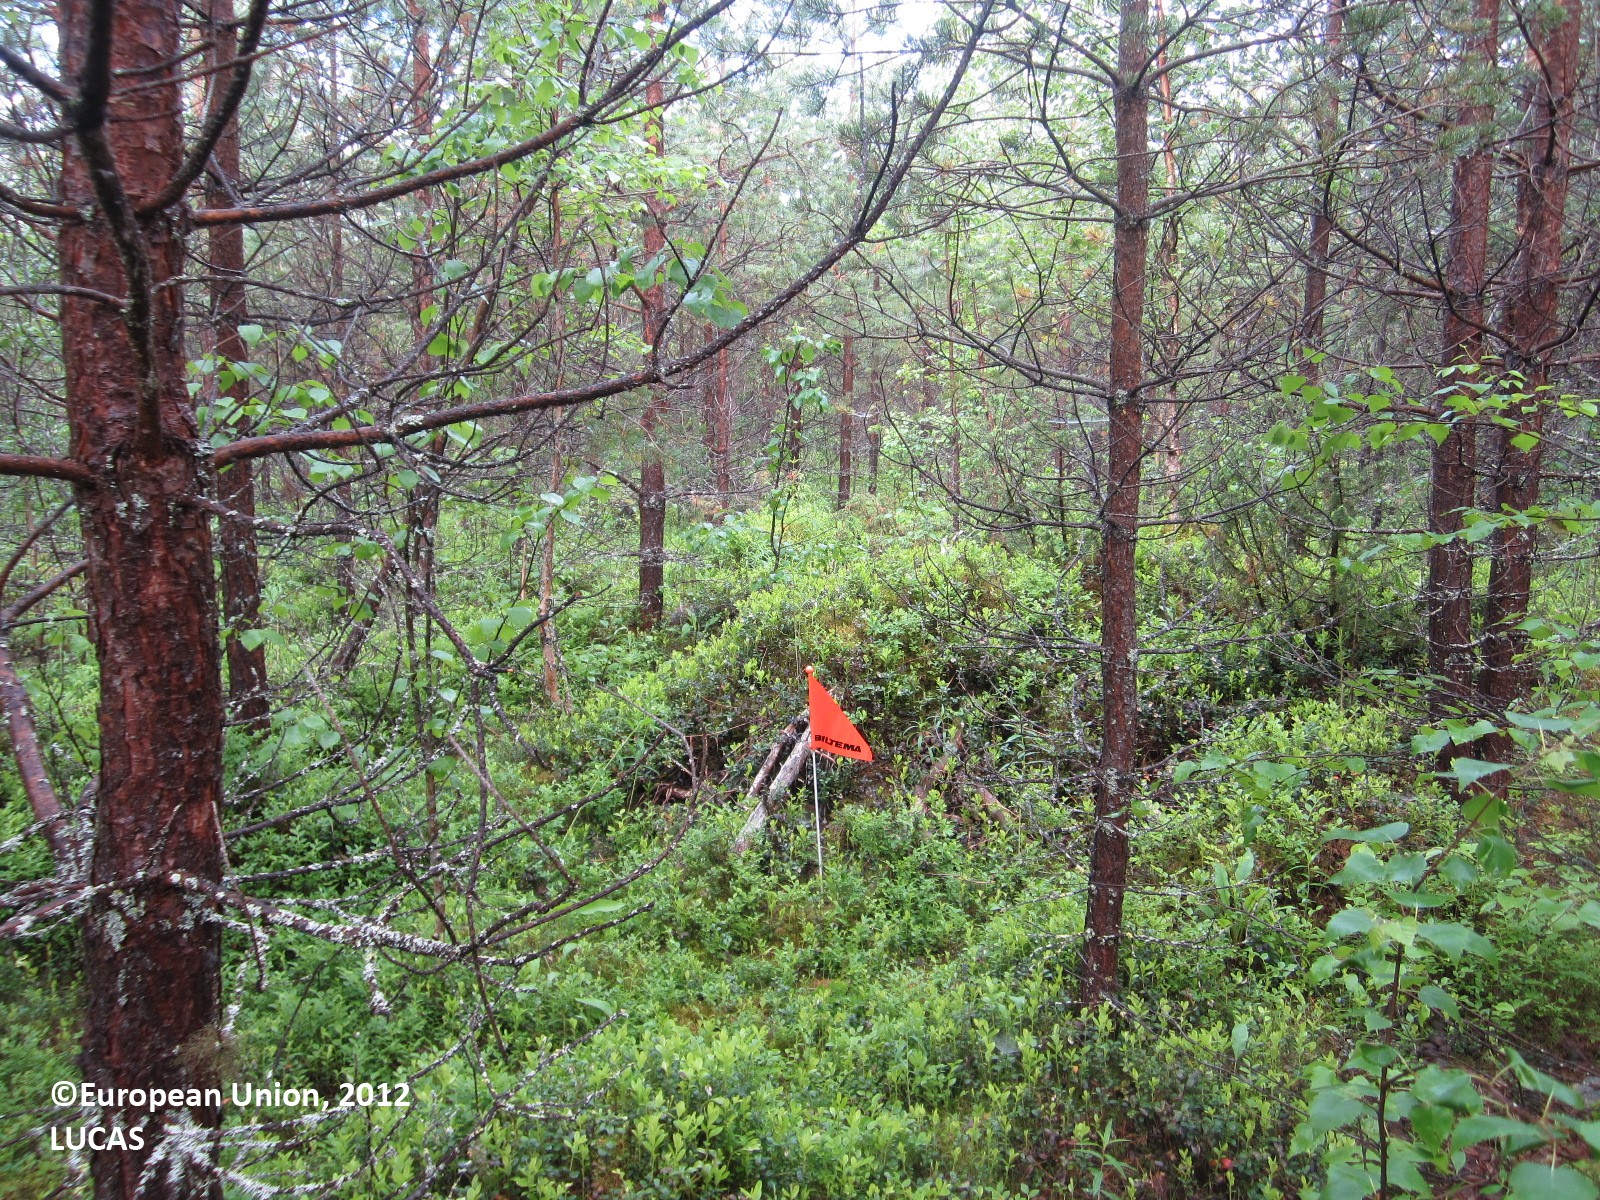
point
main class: Woodland
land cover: Pine dominated coniferous woodland
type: boreal forest
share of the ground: > 75 %
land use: Forestry
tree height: > 5 m
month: June
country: FI
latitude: 64.5097
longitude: 29.5630
